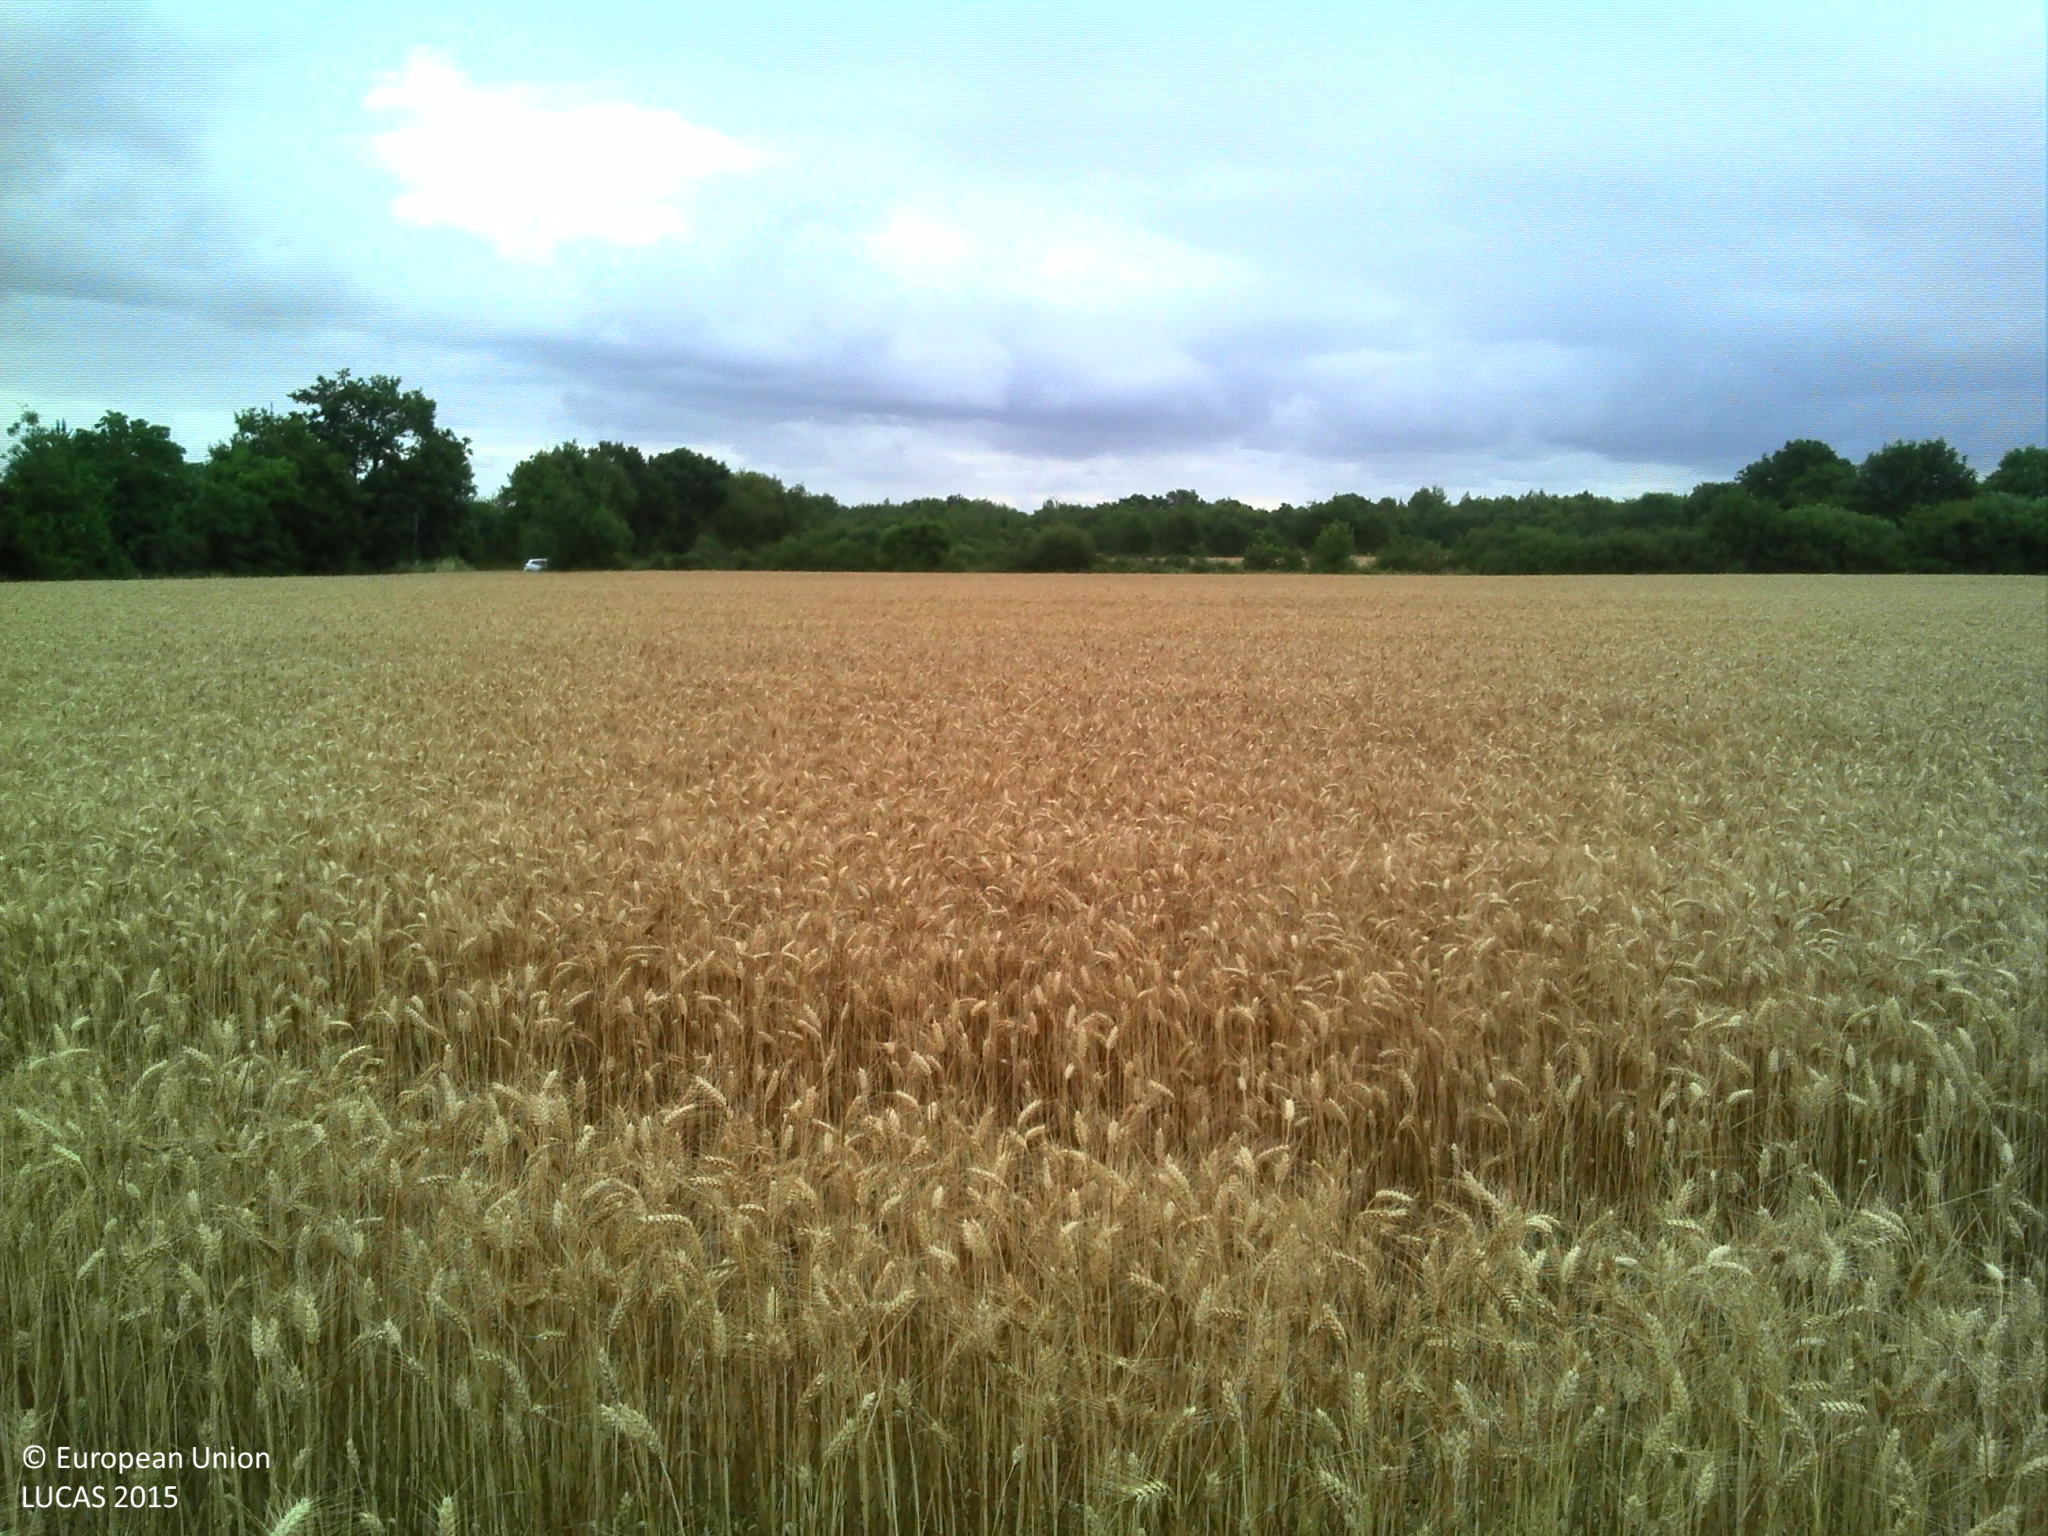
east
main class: Cropland
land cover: Common wheat
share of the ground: > 75 %
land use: Agriculture (excluding fallow land and kitchen gardens)
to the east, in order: Common wheat; Managed hedges; Ditches and canals; Grass margins; Tracks; Grass margins; Ditches and canals; Abandoned hedges; Common wheat
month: July
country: FR
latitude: 46.9973
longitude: -1.7075
